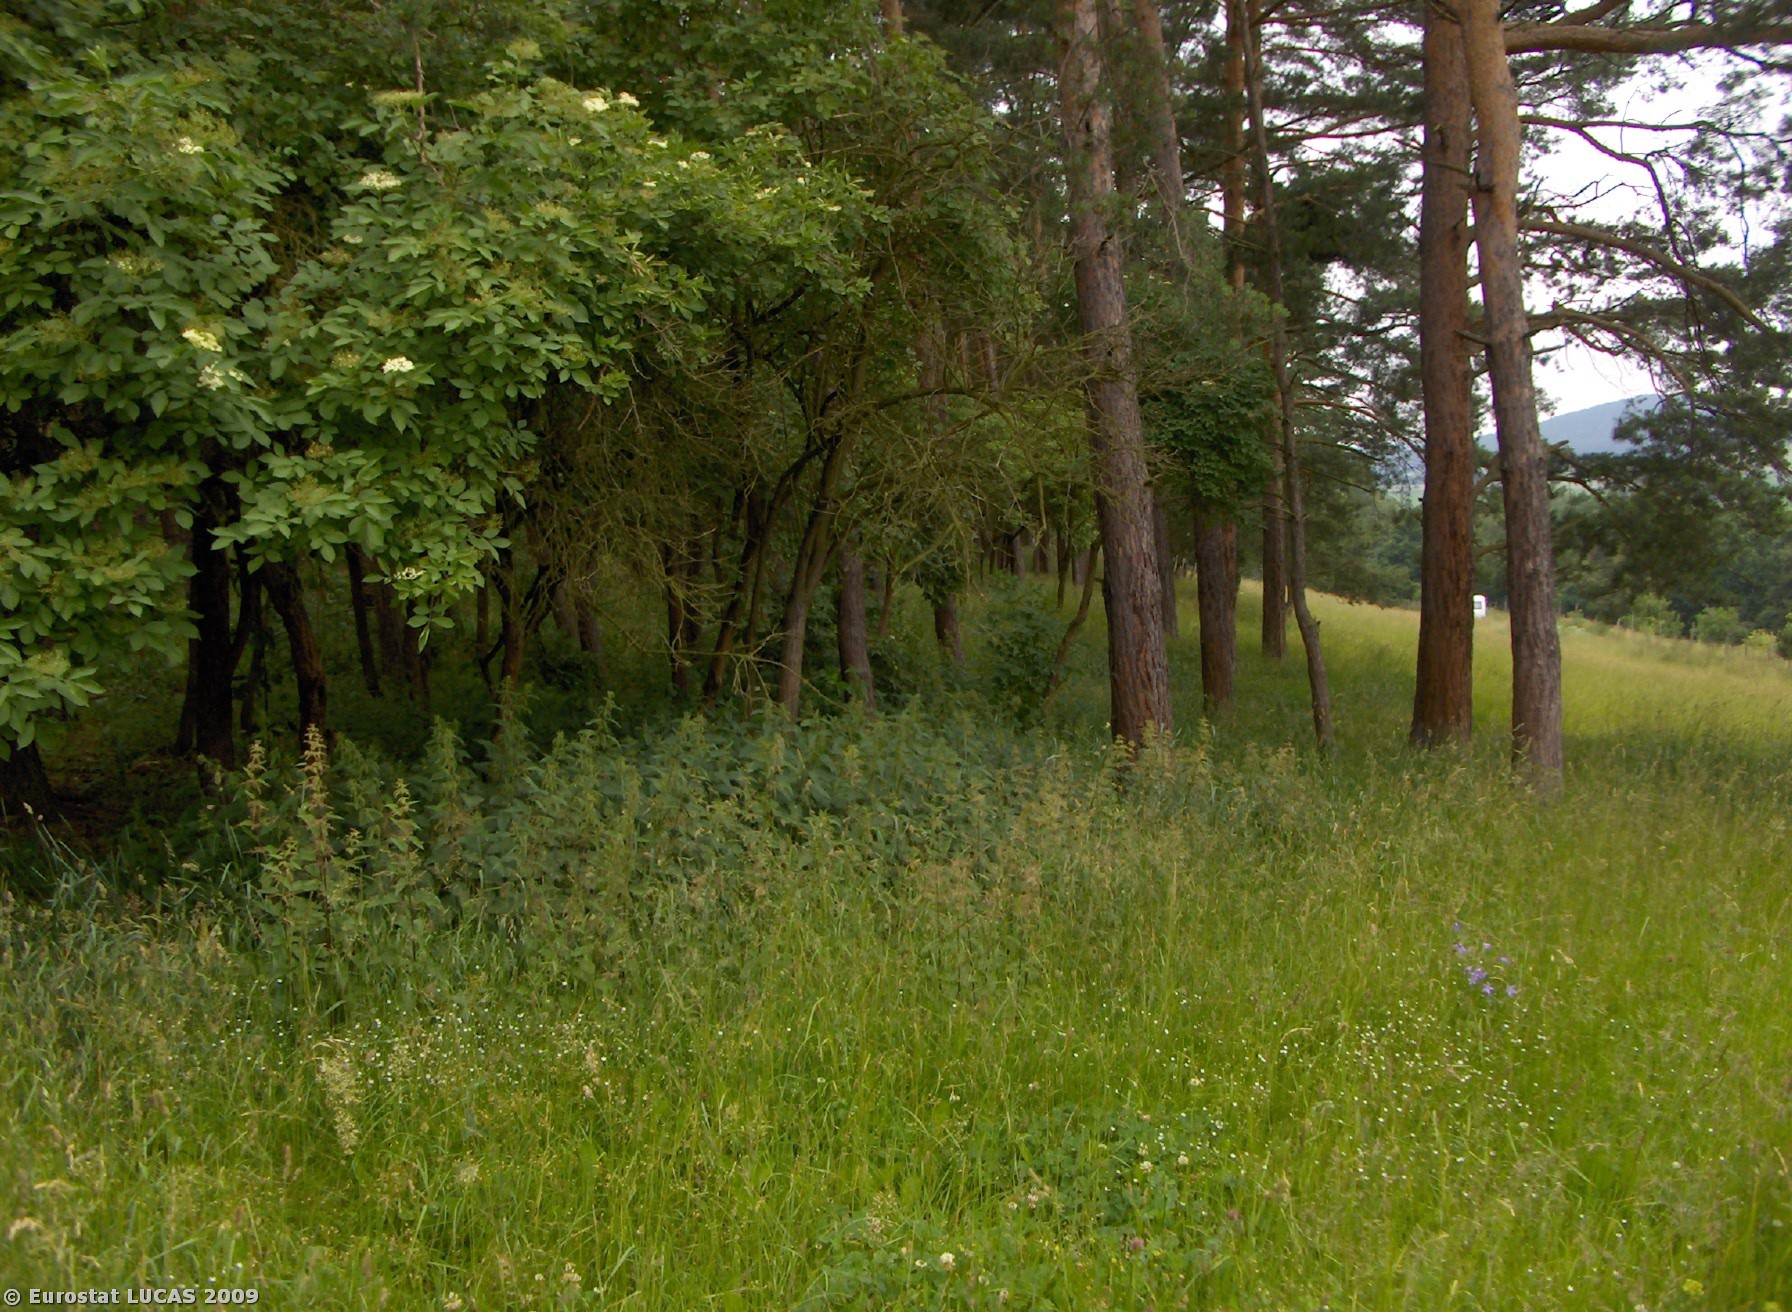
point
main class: Woodland
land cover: Mixed woodland
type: hemiboreal forest and nemoral coniferous forest and mixed broadleaved-coniferous forest
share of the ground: > 75 %
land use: Forestry
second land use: Agriculture (excluding fallow land and kitchen gardens)
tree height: > 5 m
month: June
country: CZ
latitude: 49.7761
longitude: 14.3756
